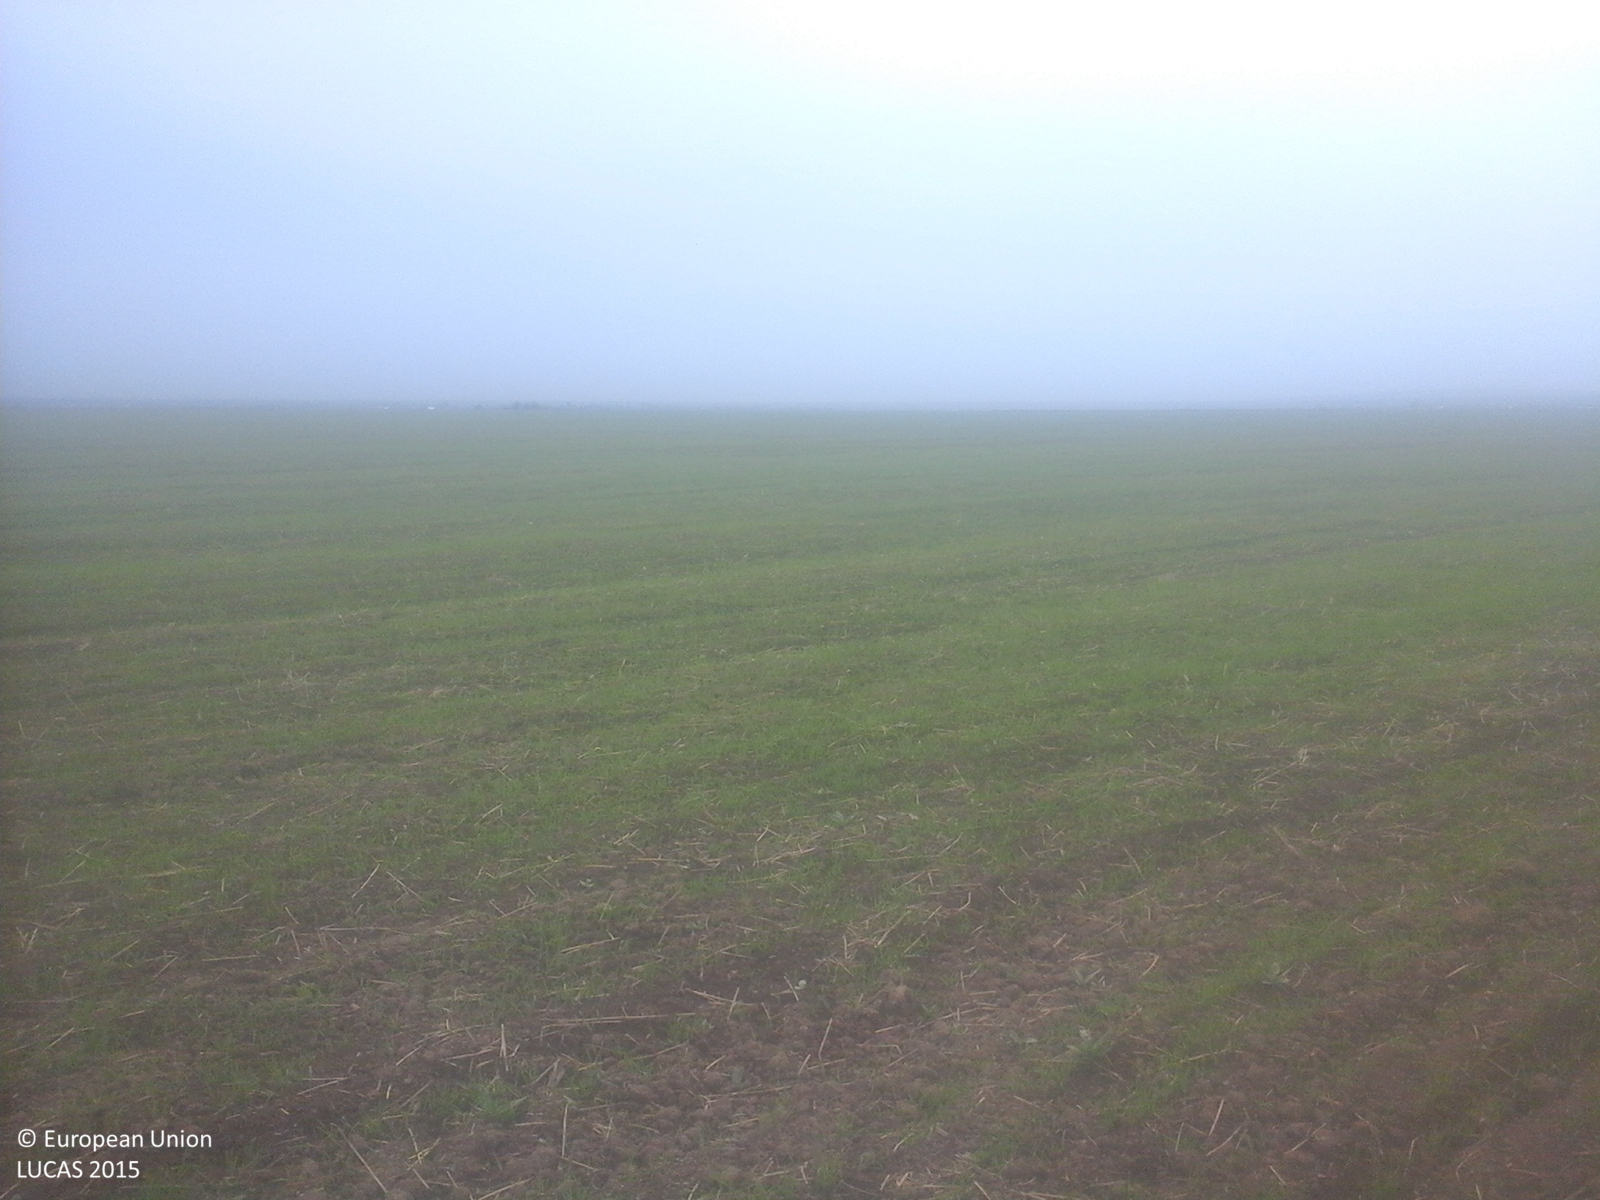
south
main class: Cropland
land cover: Common wheat
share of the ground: 10 - 25 %
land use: Agriculture (excluding fallow land and kitchen gardens)
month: October
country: RO
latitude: 44.9502
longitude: 25.7814
